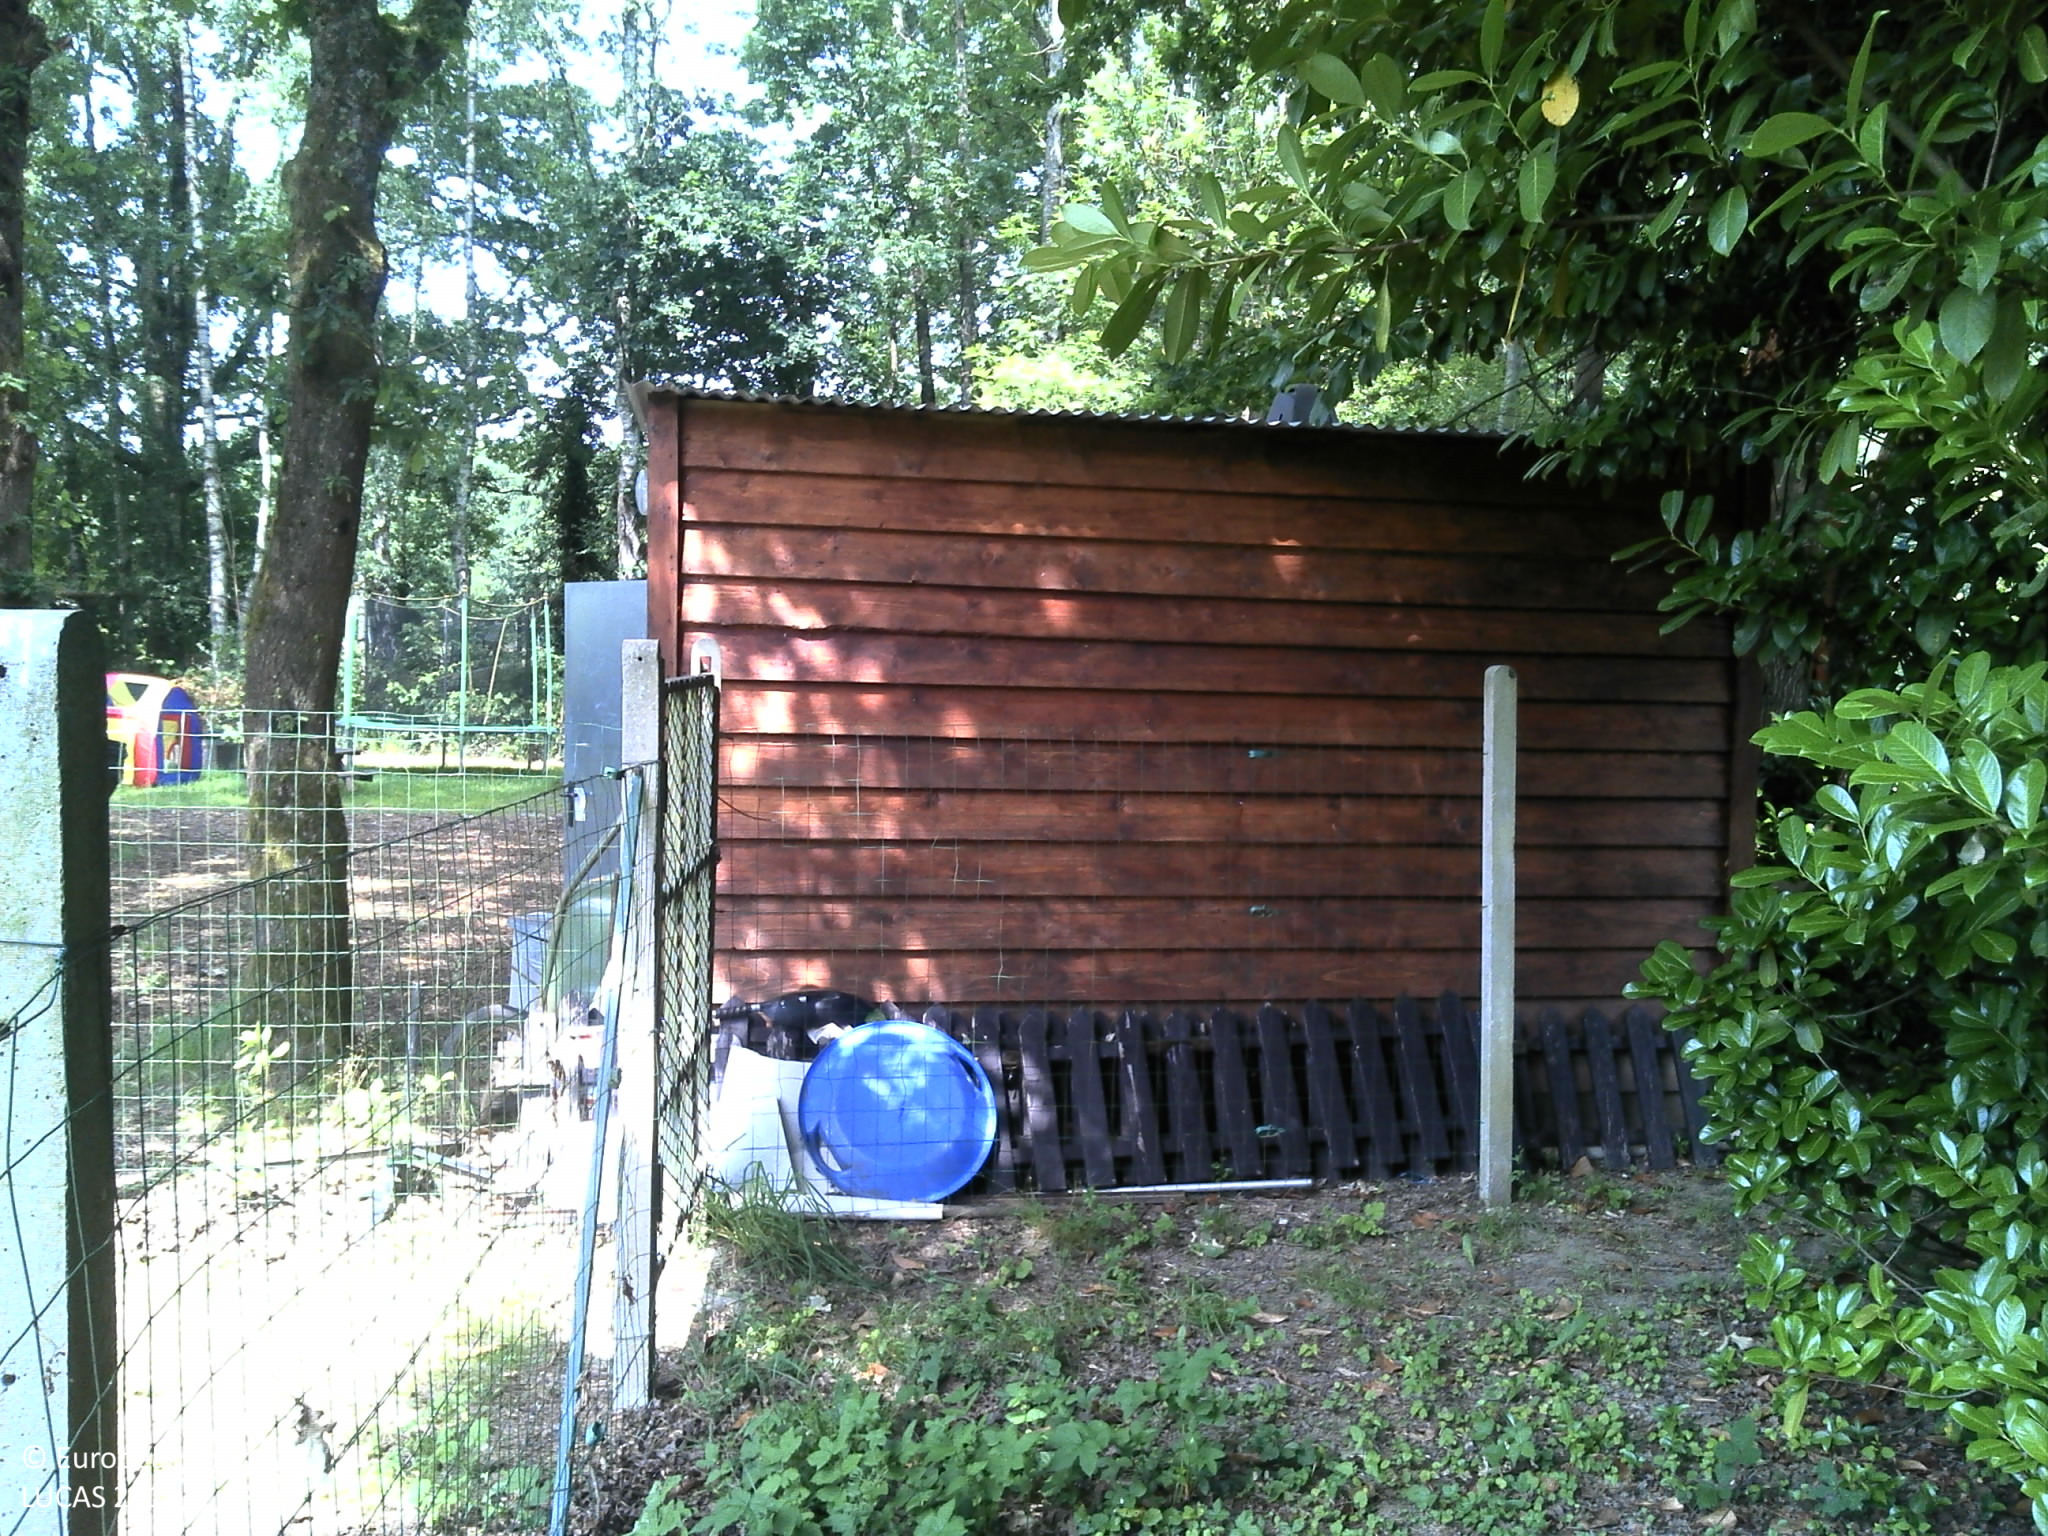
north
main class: Grassland
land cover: Grassland without tree/shrub cover
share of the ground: > 75 %
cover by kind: herbaceous plants 100 %
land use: Amenities, museums, leisure
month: July
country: FR
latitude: 49.8678
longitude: 4.8074
